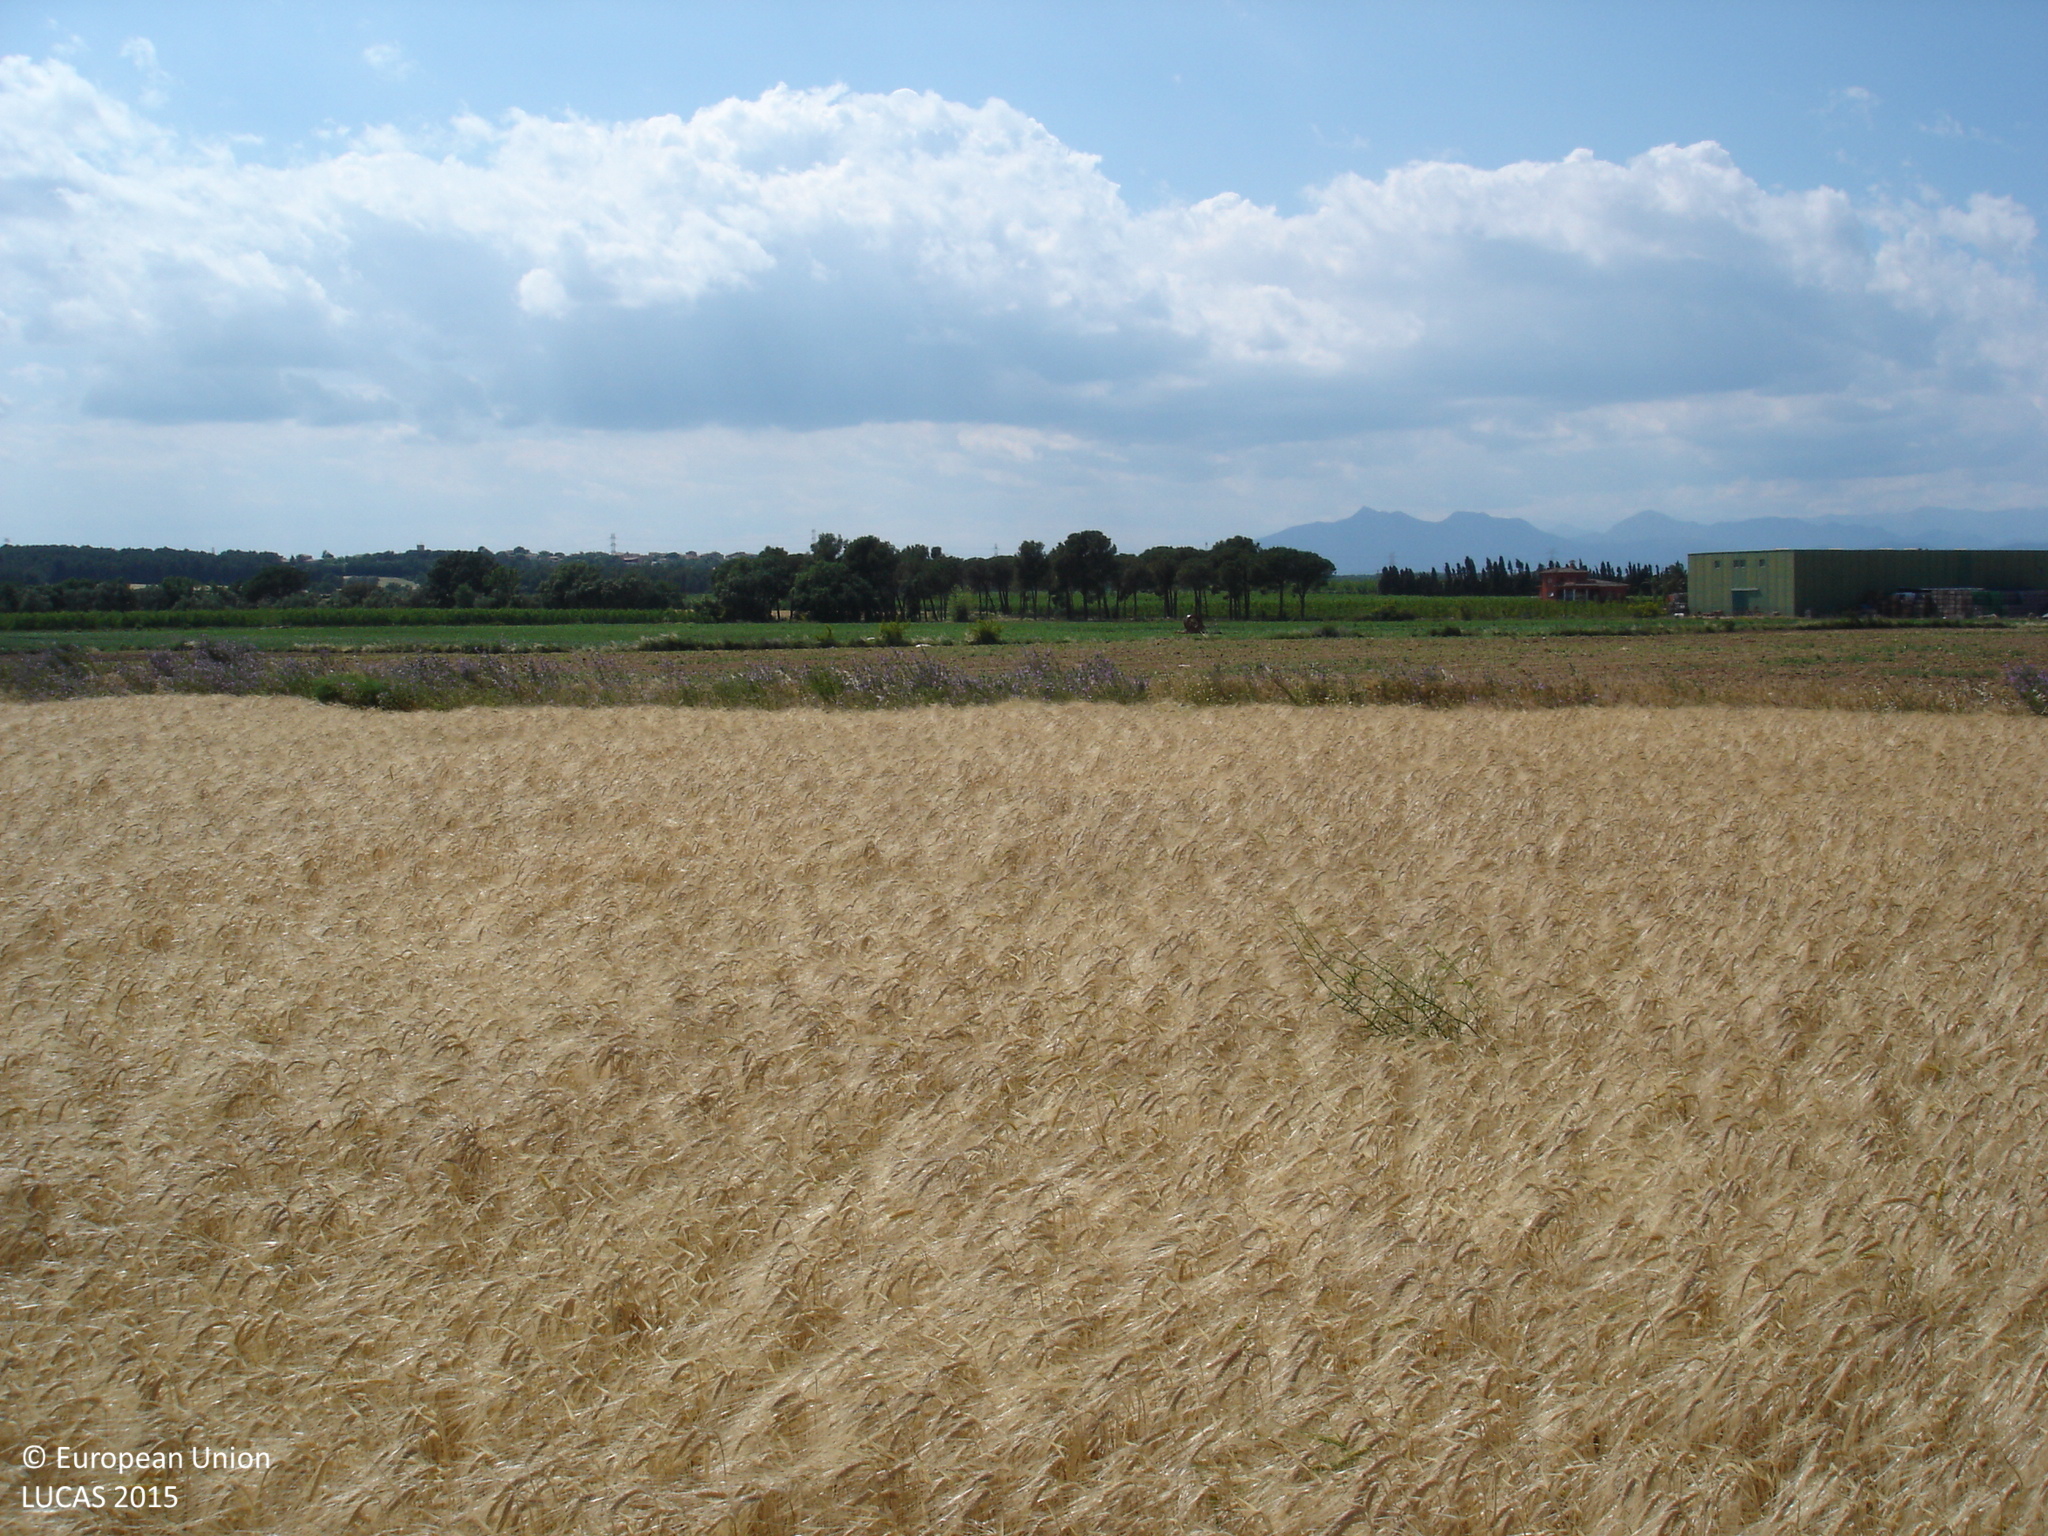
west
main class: Cropland
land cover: Barley
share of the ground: > 75 %
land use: Agriculture (excluding fallow land and kitchen gardens)
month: May
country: ES
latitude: 42.1927
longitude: 2.9791
